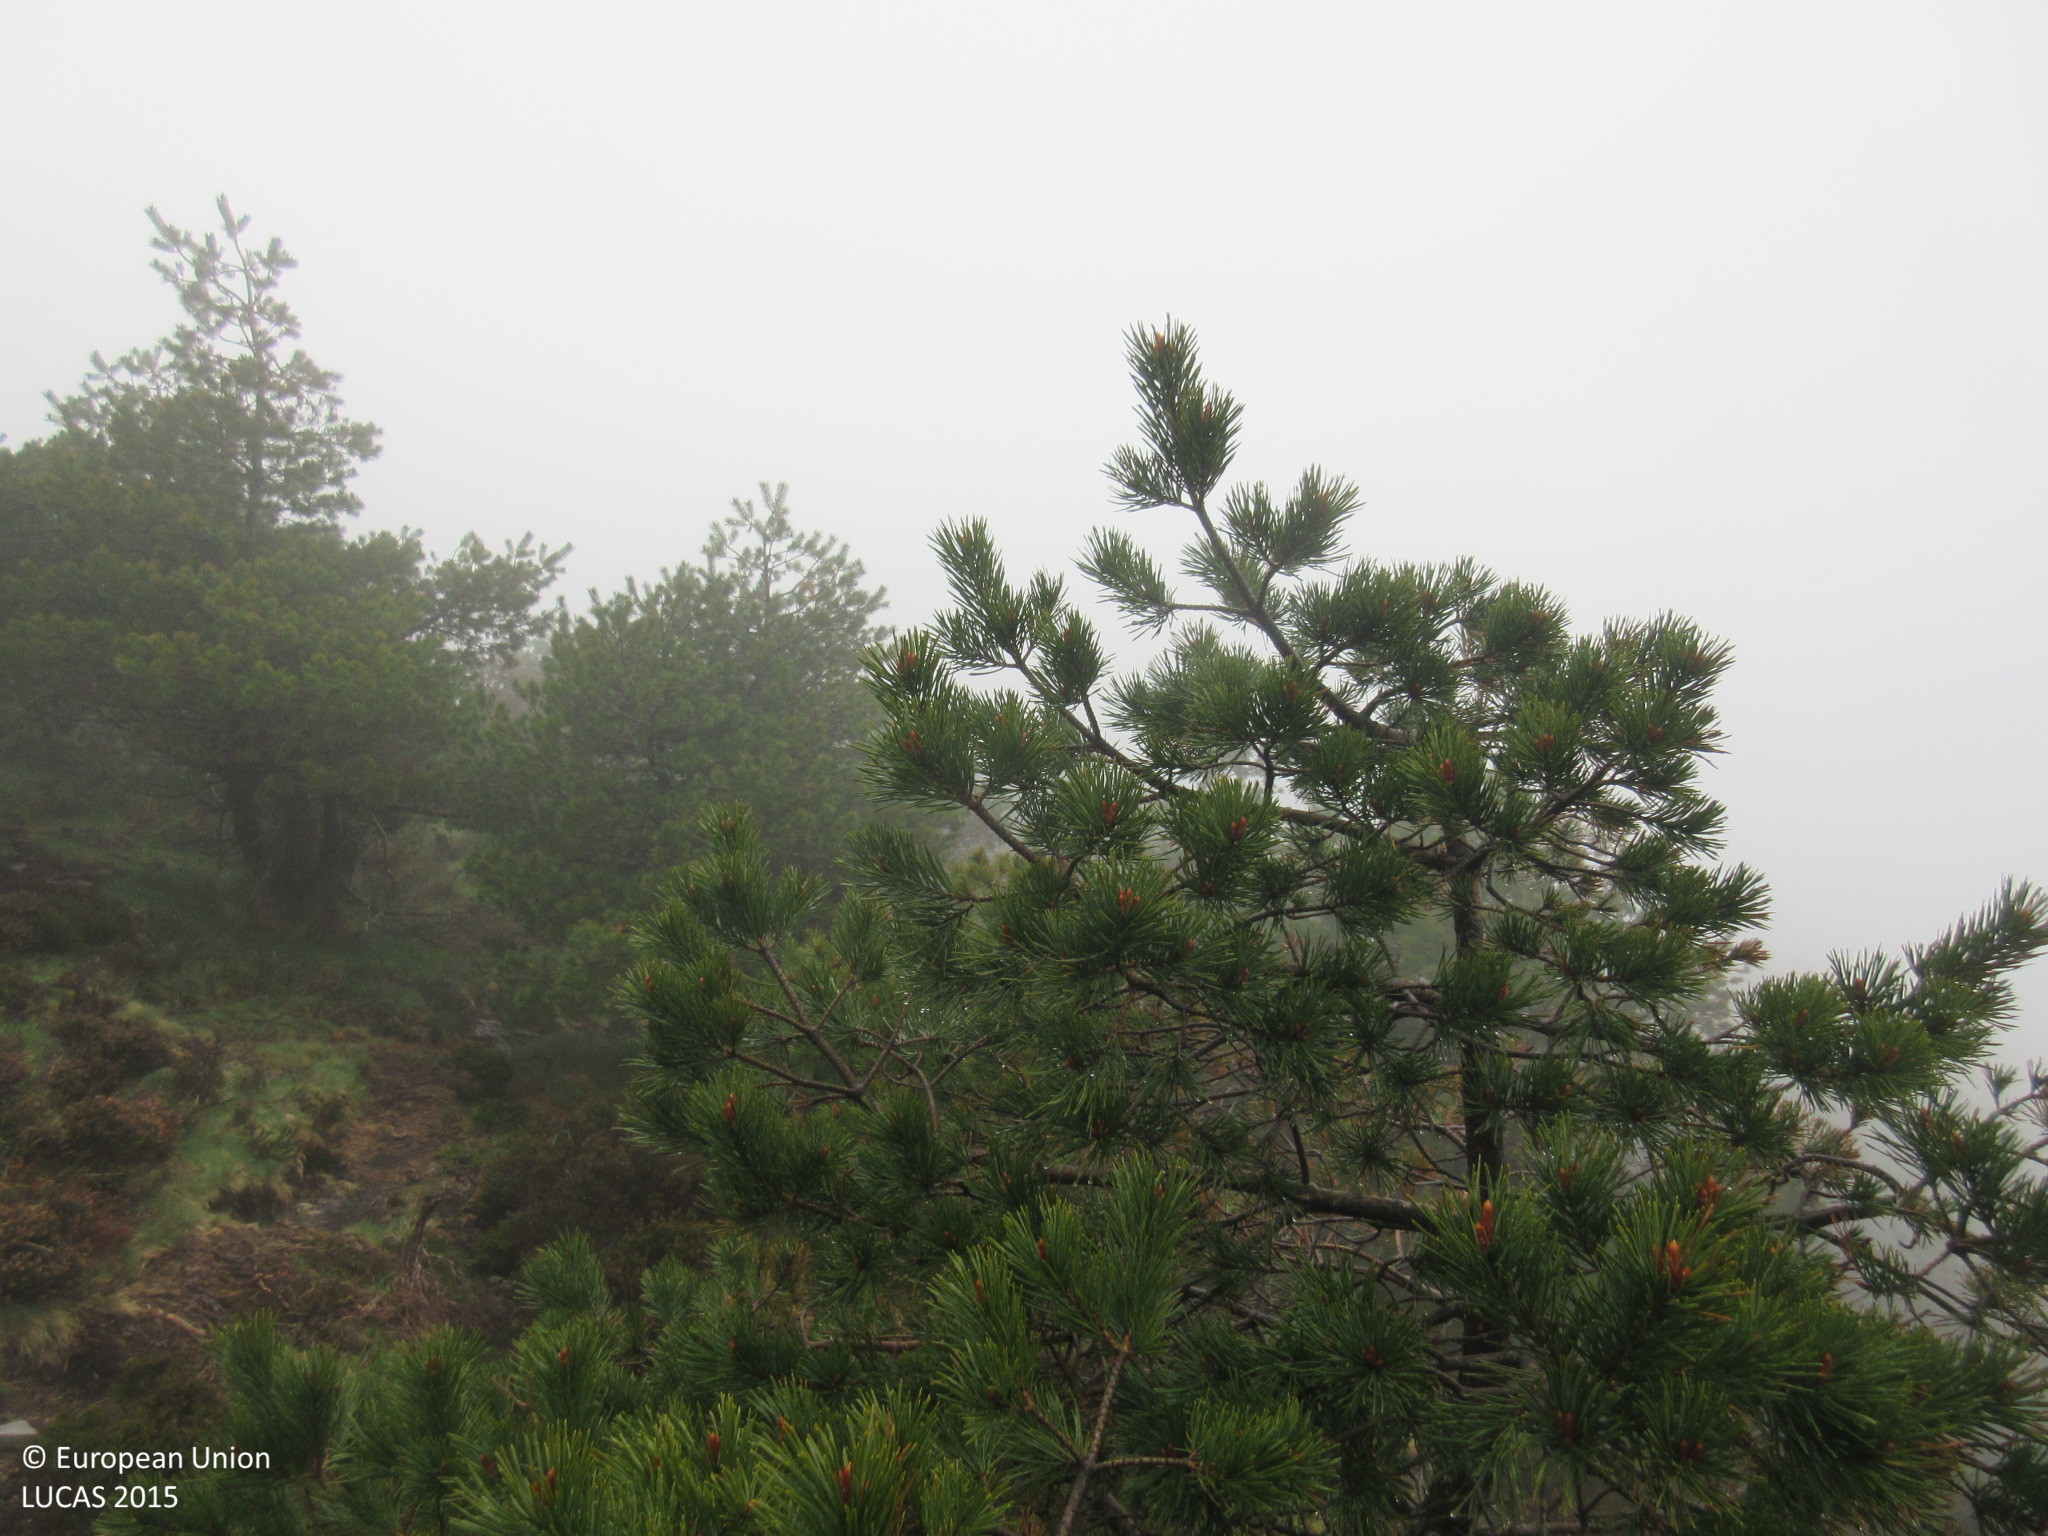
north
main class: Woodland
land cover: Pine dominated coniferous woodland
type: exotic forest
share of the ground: > 75 %
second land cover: Shrubland without tree cover
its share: > 75 %
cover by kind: coniferous forest trees 85 %, shrubs 15 %
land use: Forestry
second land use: Agriculture (excluding fallow land and kitchen gardens)
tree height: < 5 m
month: April
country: ES
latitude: 43.3695
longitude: -6.9348
